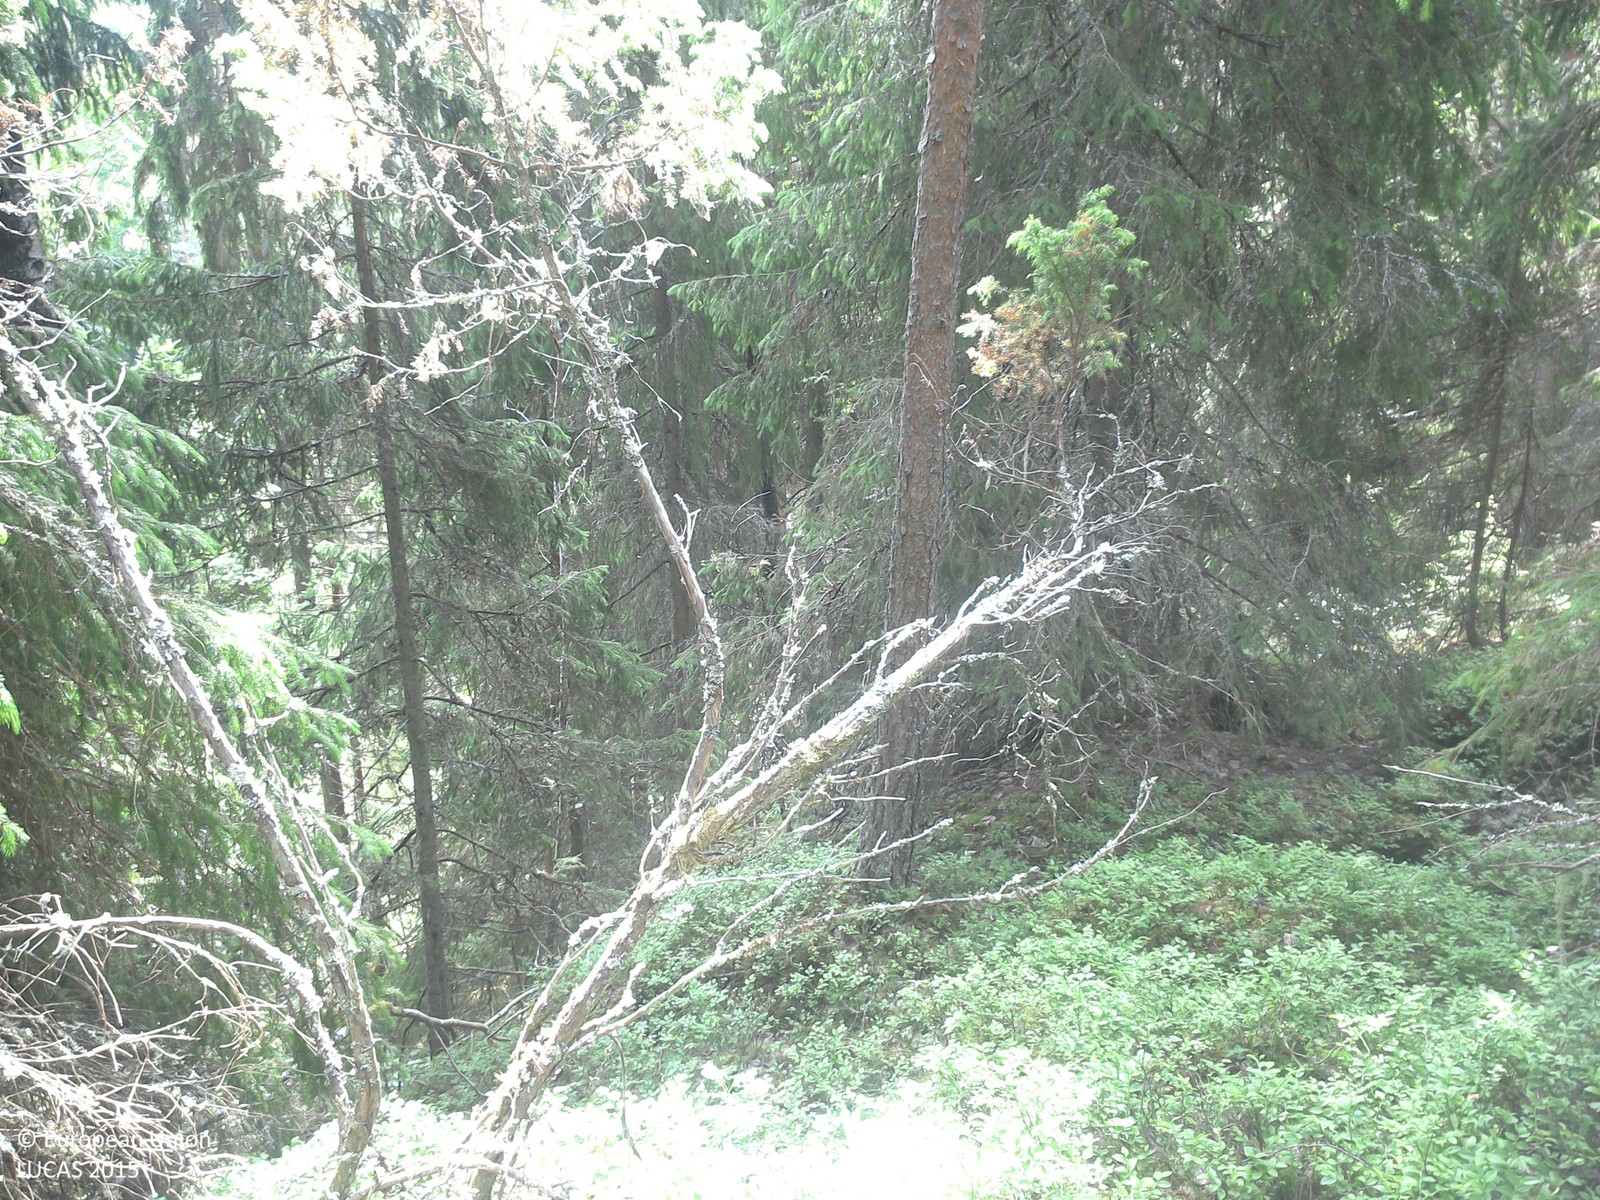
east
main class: Woodland
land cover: Spruce dominated coniferous woodland
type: boreal forest
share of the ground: 50 - 75 %
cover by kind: coniferous forest trees 60 %, lichens and mosses 20 %, herbaceous plants 15 %, broadleaved forest trees 5 %
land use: Forestry
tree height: > 5 m
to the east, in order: Spruce dominated coniferous woodland; Ditches and canals; Spruce dominated coniferous woodland; Pine dominated coniferous woodland; Paved roads, cycling and walking lanes; Pine dominated coniferous woodland; Spruce dominated coniferous woodland
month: June
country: SE
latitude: 58.1424
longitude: 15.5159
